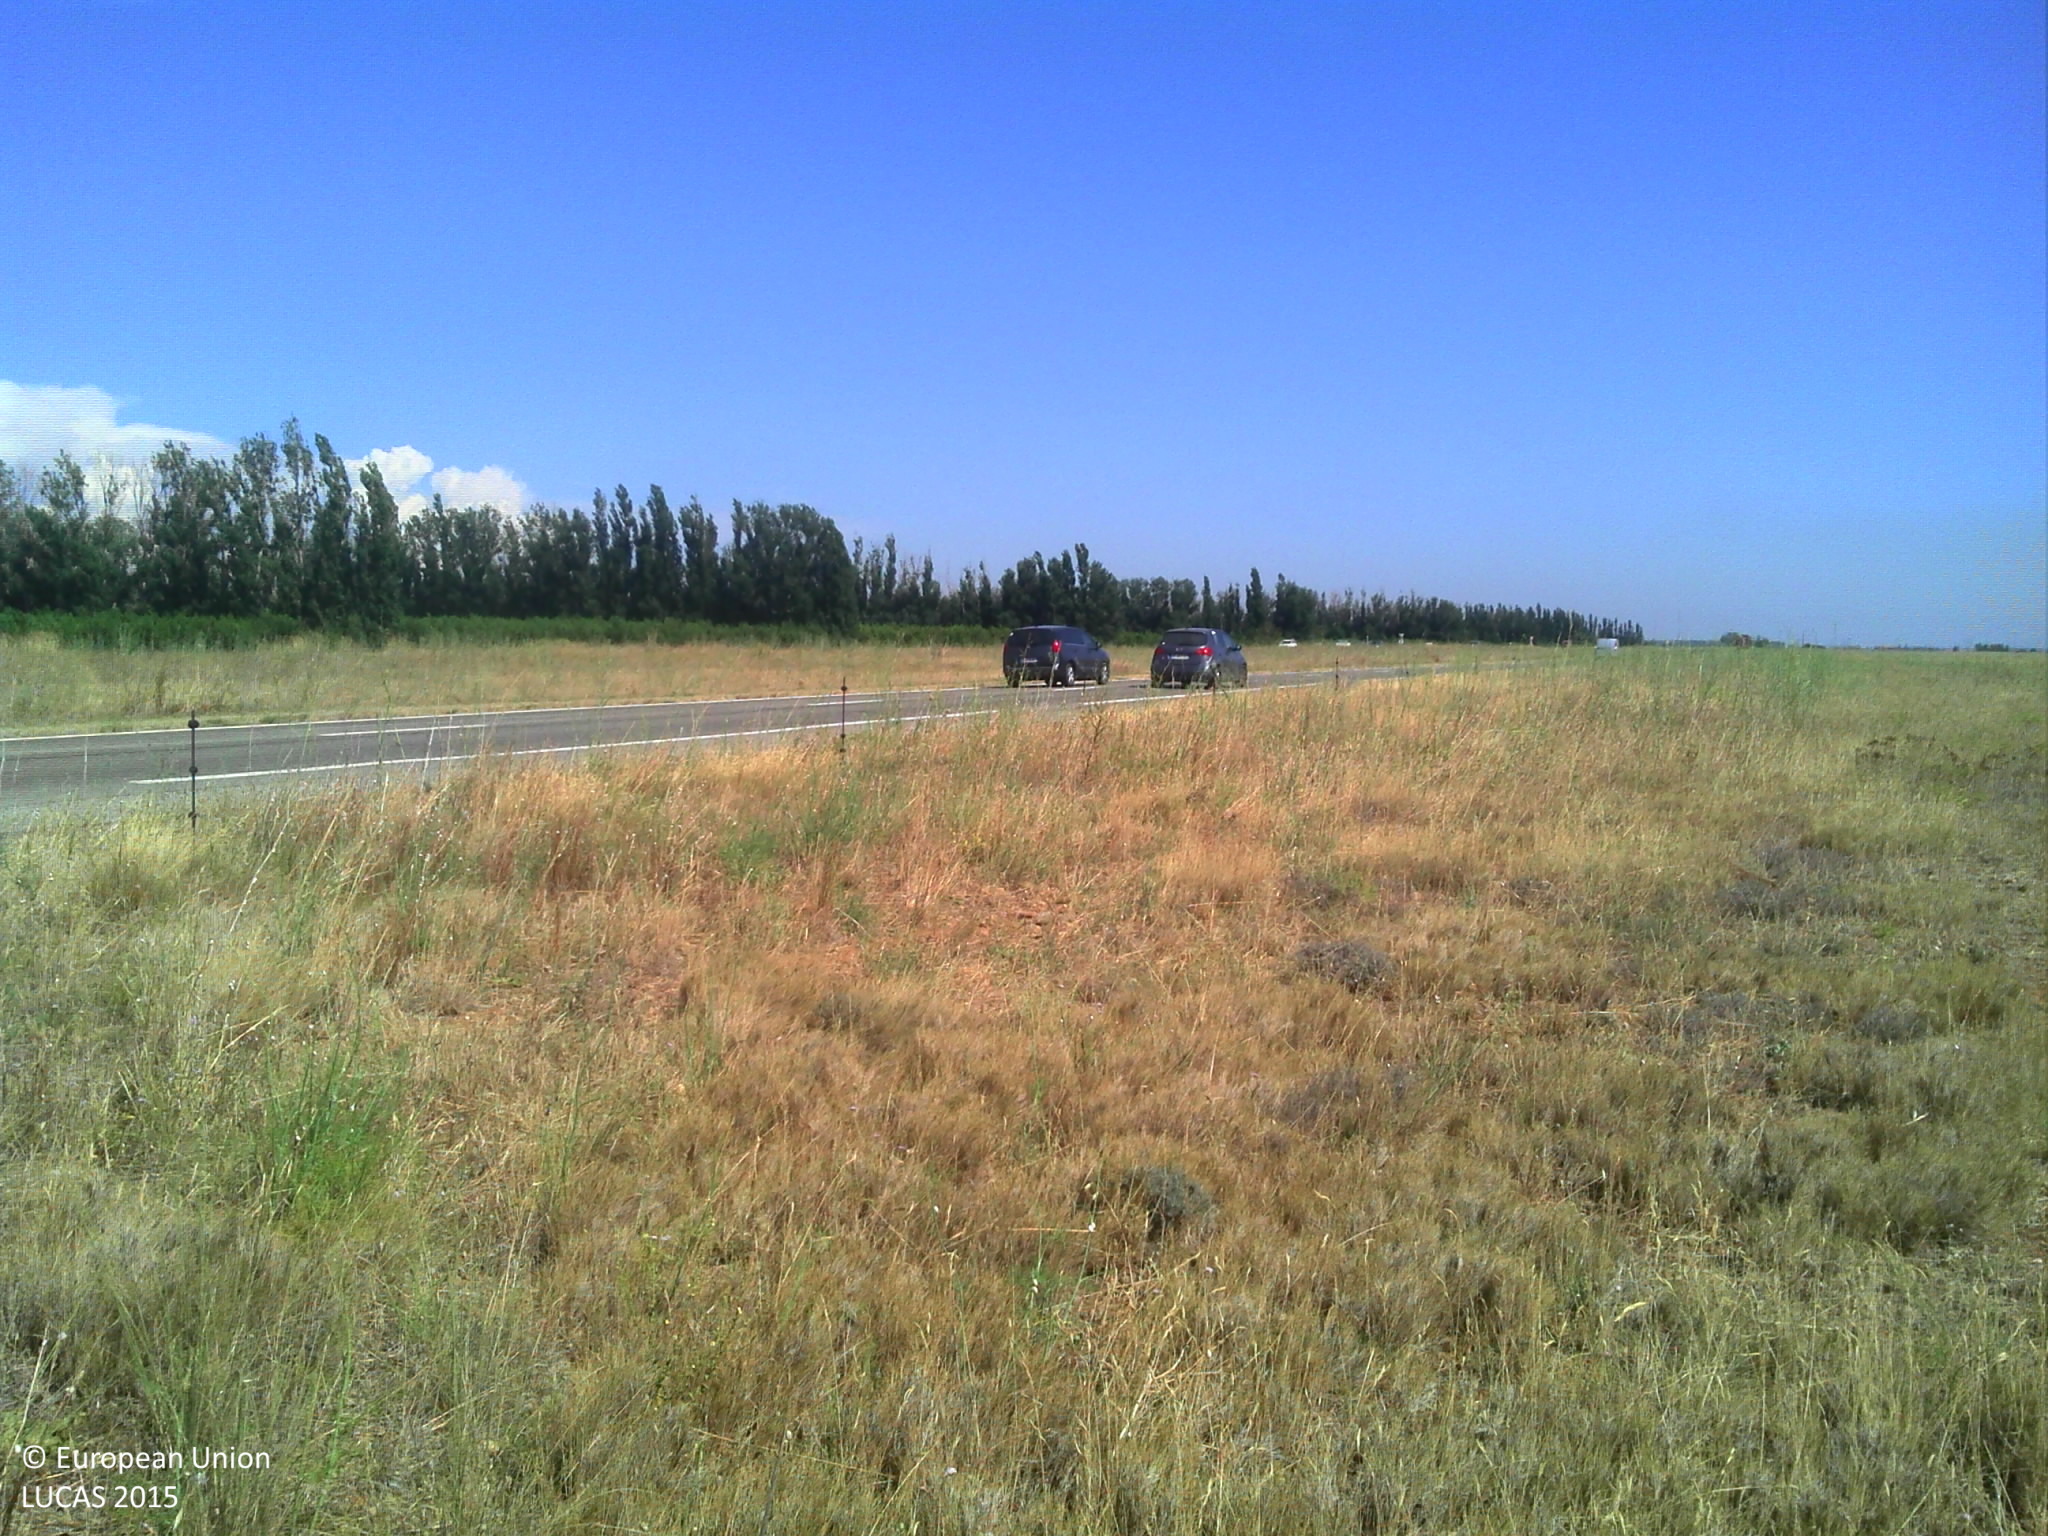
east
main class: Grassland
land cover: Grassland without tree/shrub cover
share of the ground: > 75 %
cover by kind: herbaceous plants 55 %, unconsolidated bare surface 45 %
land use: Agriculture (excluding fallow land and kitchen gardens)
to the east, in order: Grassland without tree/shrub cover; Fences; Other bare soil; Paved roads, cycling and walking lanes; Grassland without tree/shrub cover; Paved roads, cycling and walking lanes; Grassland without tree/shrub cover; Other fruit trees and berries; Lines of trees; Other fruit trees and berries; Tracks; Other fruit trees and berries
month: July
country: FR
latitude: 43.5346
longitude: 4.8250
